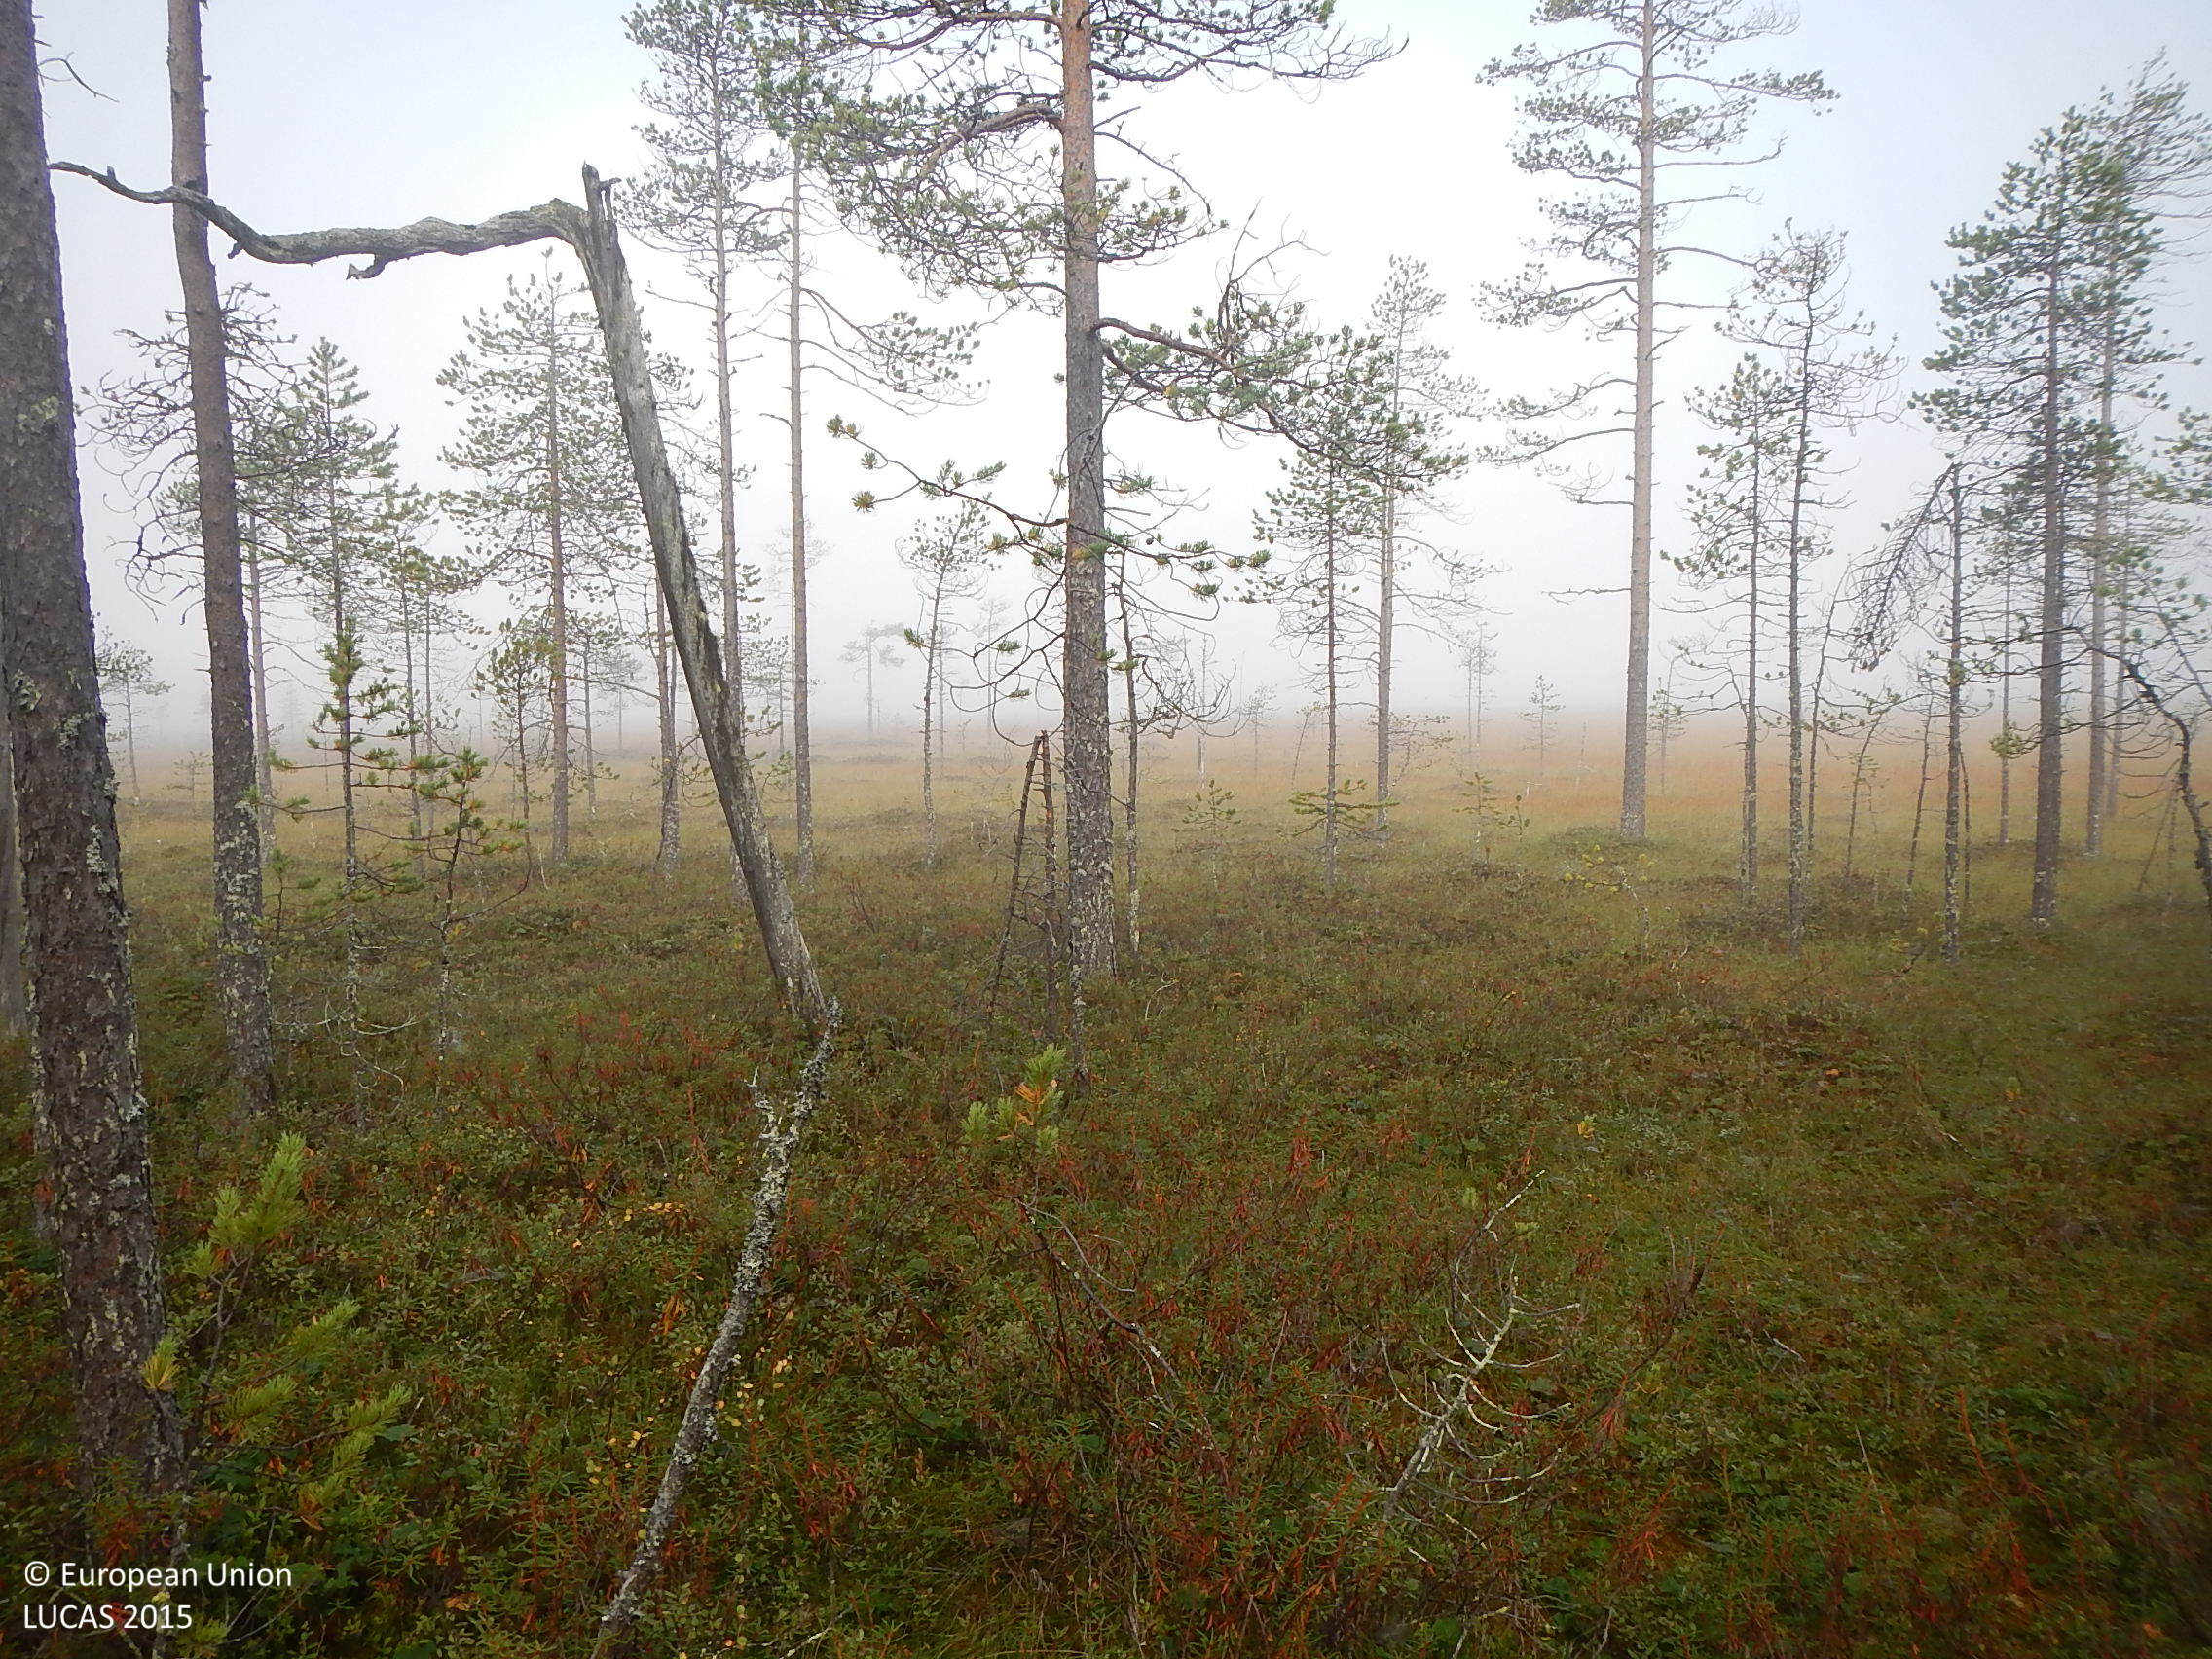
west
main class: Woodland
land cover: Pine dominated coniferous woodland
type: mire and swamp forests
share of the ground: 25 - 50 %
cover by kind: coniferous forest trees 45 %, shrubs 40 %, herbaceous plants 10 %, lichens and mosses 5 %
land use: Forestry
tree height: > 5 m
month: August
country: FI
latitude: 65.5148
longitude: 27.0026
